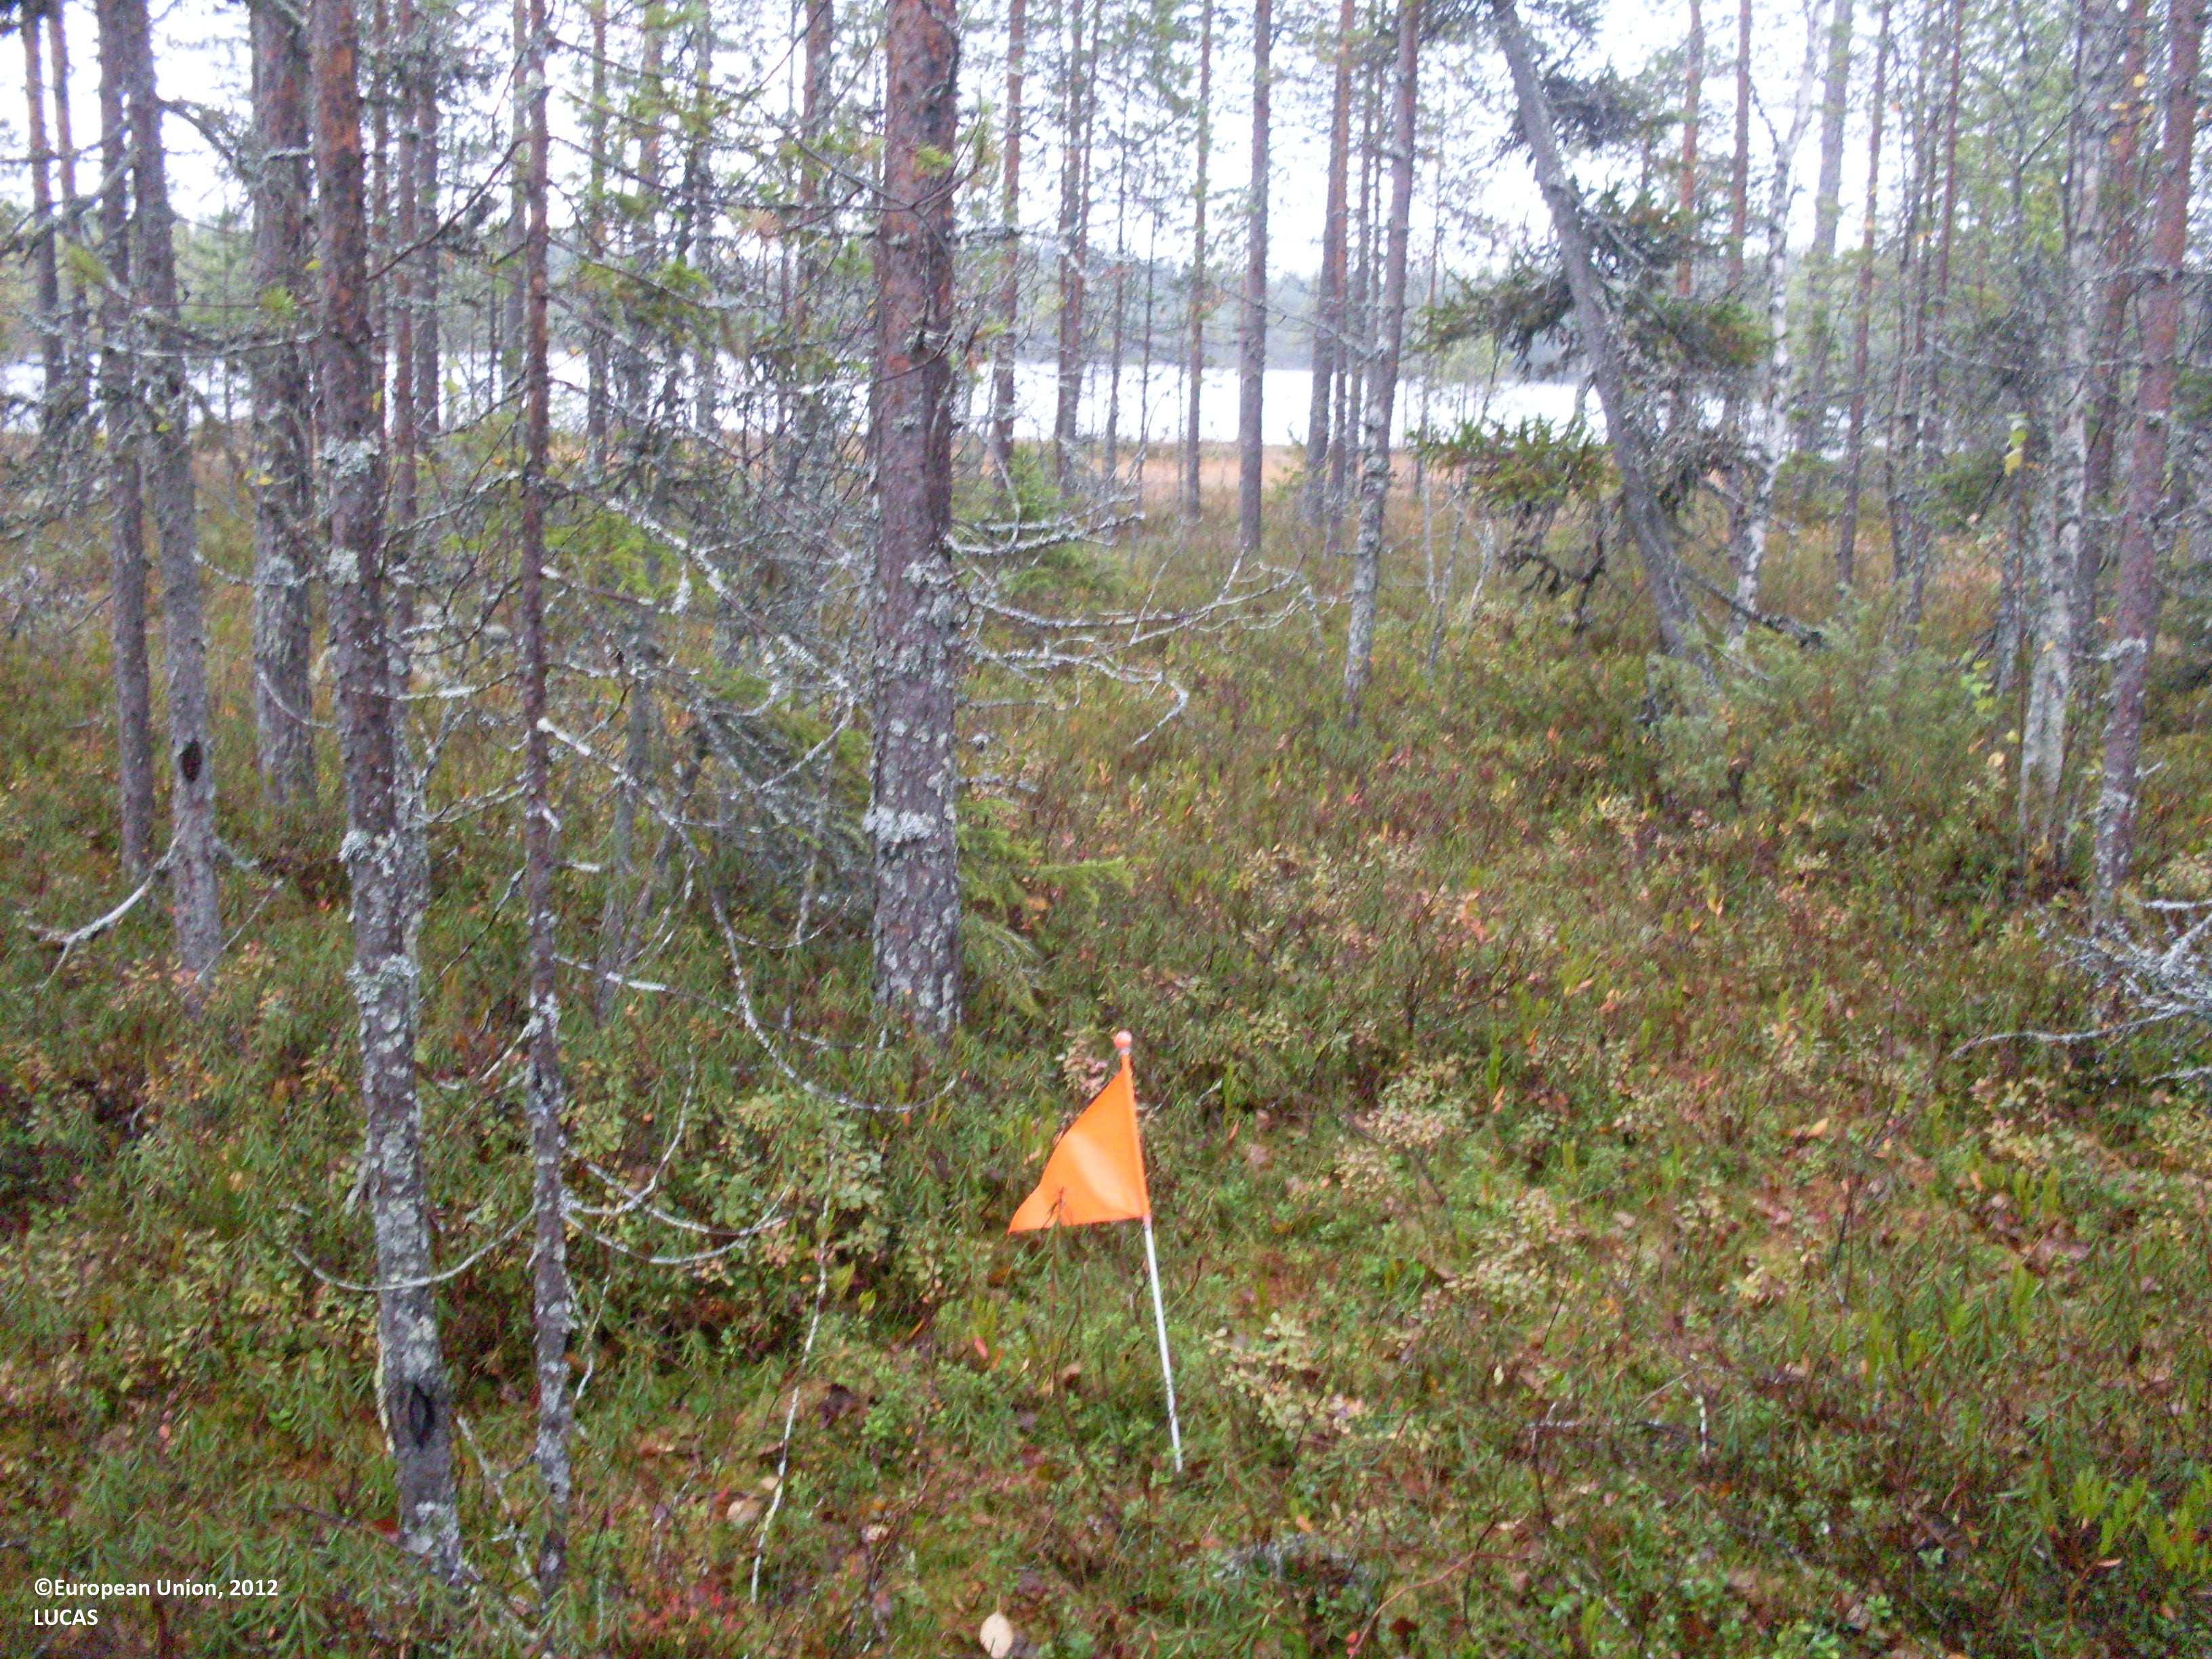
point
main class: Woodland
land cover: Pine dominated coniferous woodland
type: boreal forest
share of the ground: 50 - 75 %
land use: Forestry
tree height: > 5 m
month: September
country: FI
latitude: 64.3990
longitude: 29.0951
